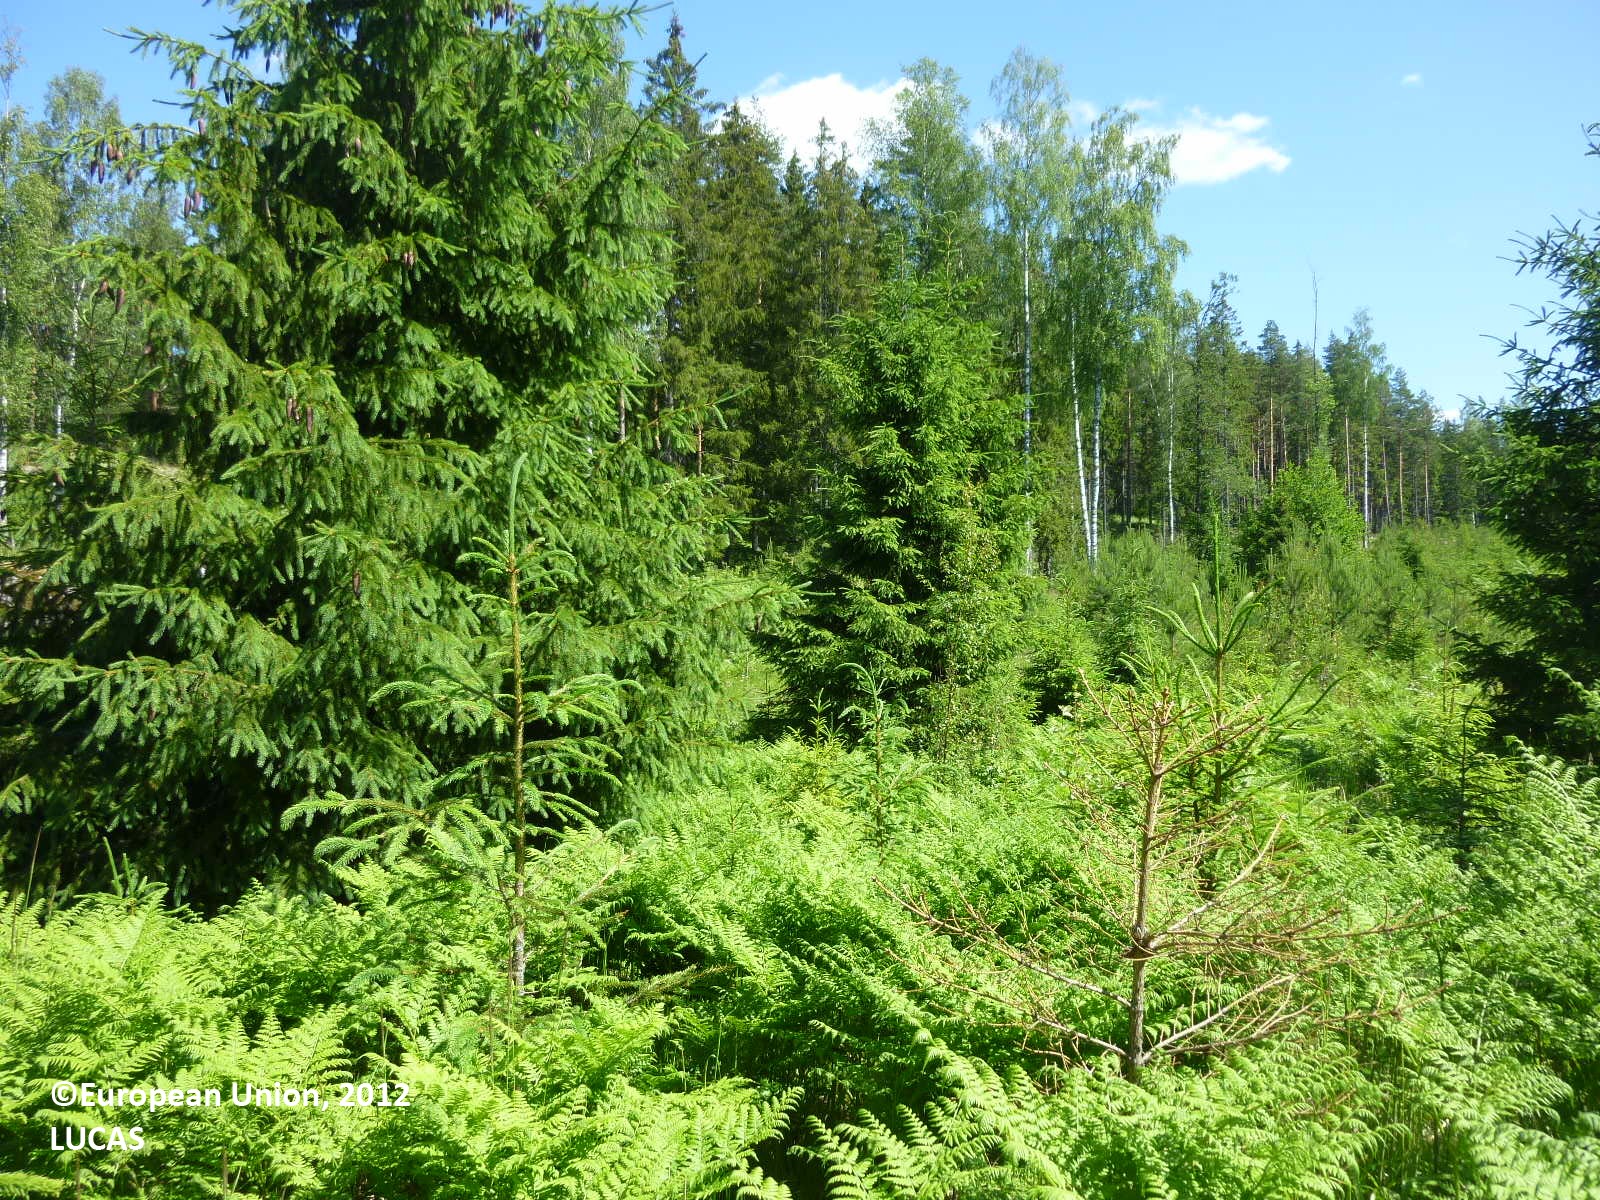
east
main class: Woodland
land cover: Spruce dominated coniferous woodland
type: boreal forest
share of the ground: < 10 %
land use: Forestry
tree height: > 5 m
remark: Clear cut
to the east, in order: Spruce dominated coniferous woodland; Ditches and canals; Spruce dominated coniferous woodland; Ditches and canals; Spruce dominated coniferous woodland; Shrubland without tree cover; Electric lines; Shrubland without tree cover; Spruce dominated coniferous woodland; Ditches and canals; Spruce dominated coniferous woodland
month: June
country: FI
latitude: 60.1434
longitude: 22.5895
